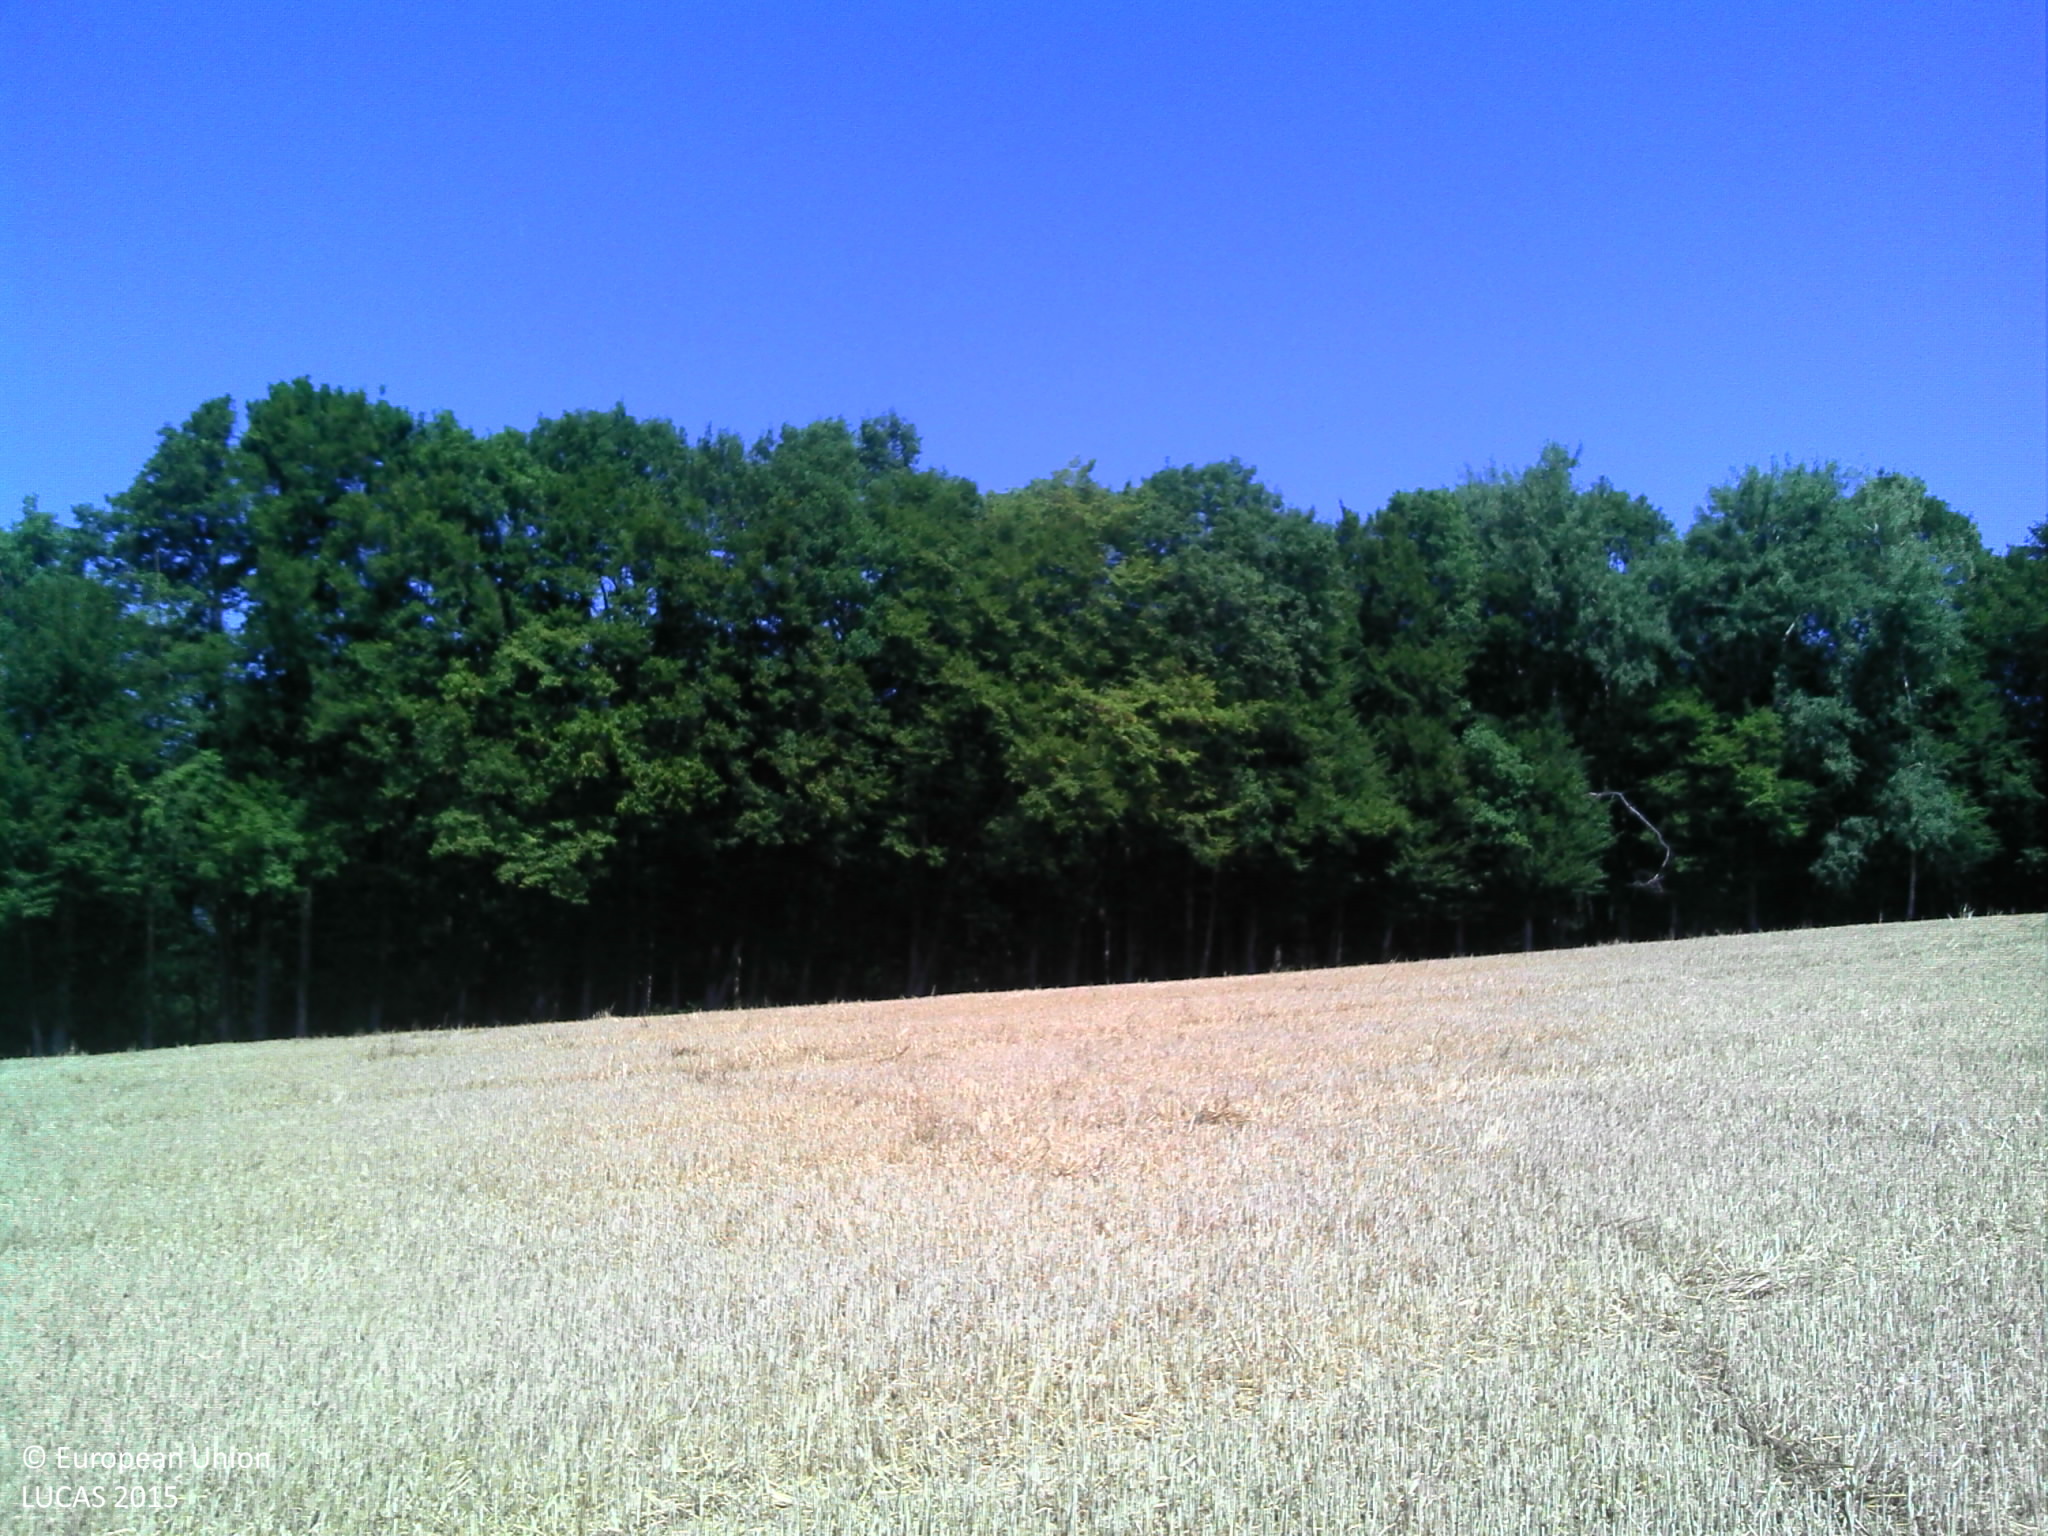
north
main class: Cropland
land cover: Common wheat
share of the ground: 10 - 25 %
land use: Agriculture (excluding fallow land and kitchen gardens)
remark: Harvested field
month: August
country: FR
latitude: 47.6709
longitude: 6.1788
